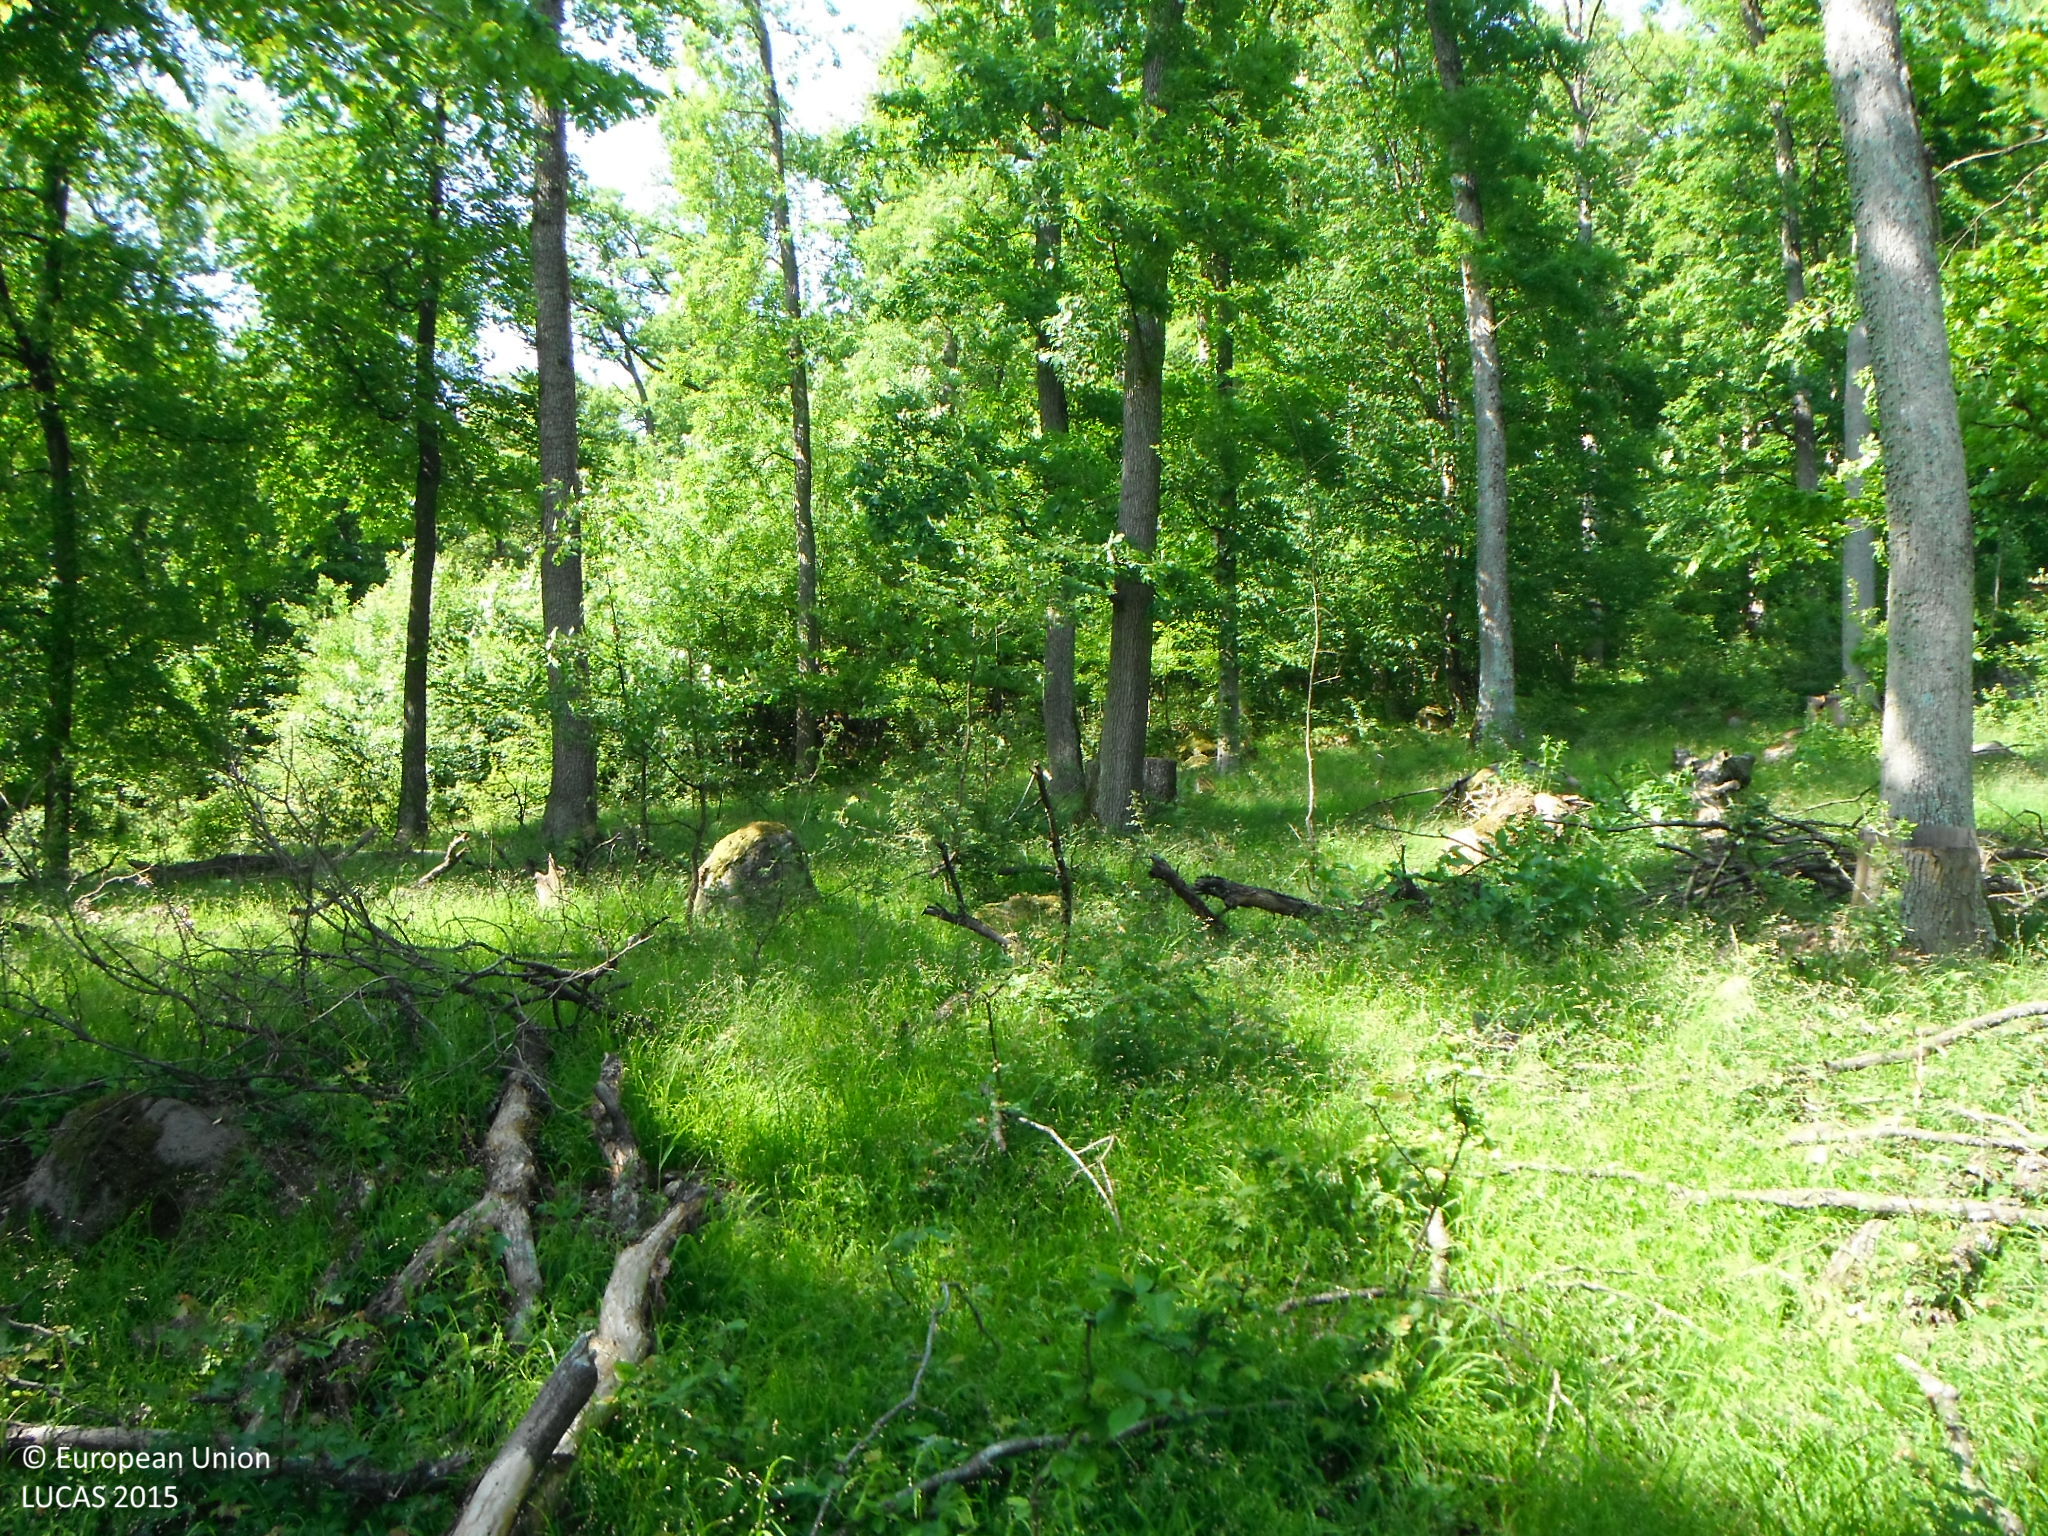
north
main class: Woodland
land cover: Broadleaved woodland
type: mesophytic deciduous forest
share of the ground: 50 - 75 %
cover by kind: broadleaved forest trees 75 %, herbaceous plants 25 %
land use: Forestry
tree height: > 5 m
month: May
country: SK
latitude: 48.3664
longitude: 18.9422
